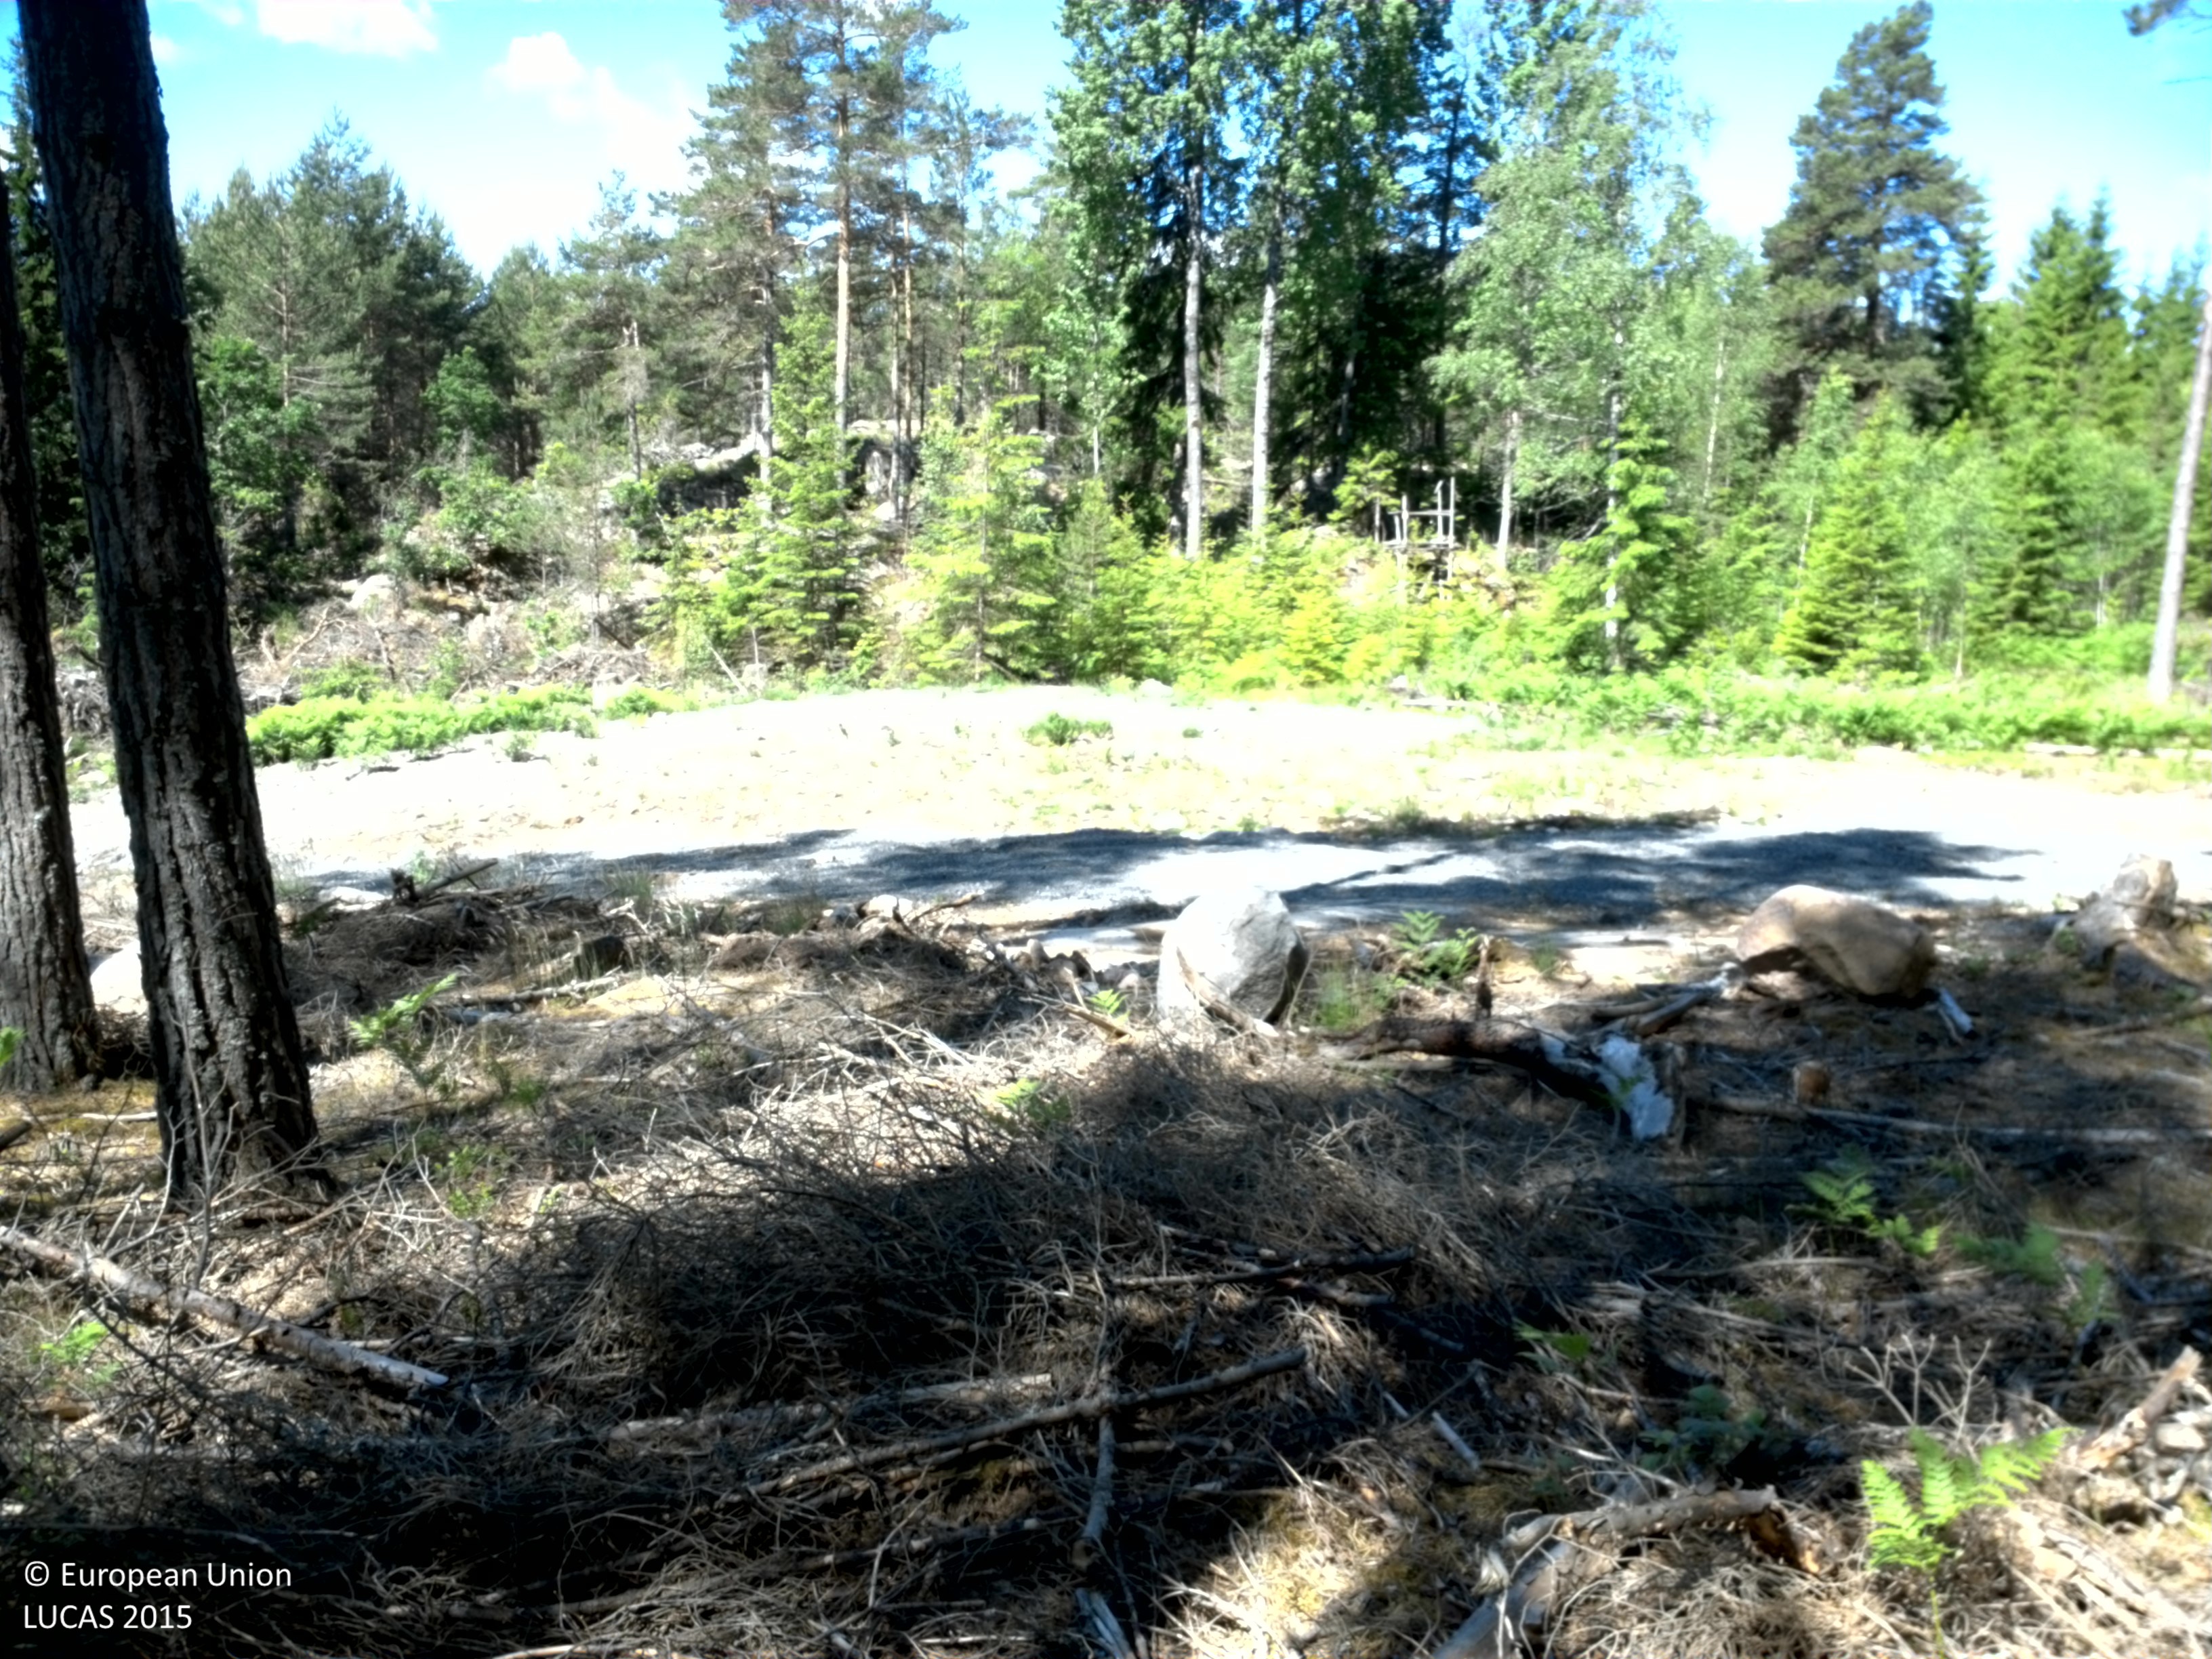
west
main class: Woodland
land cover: Pine dominated coniferous woodland
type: boreal forest
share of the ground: 25 - 50 %
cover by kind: herbaceous plants 35 %, coniferous forest trees 30 %, lichens and mosses 30 %, broadleaved forest trees 5 %
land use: Forestry
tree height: > 5 m
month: June
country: SE
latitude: 58.4110
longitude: 16.3803
